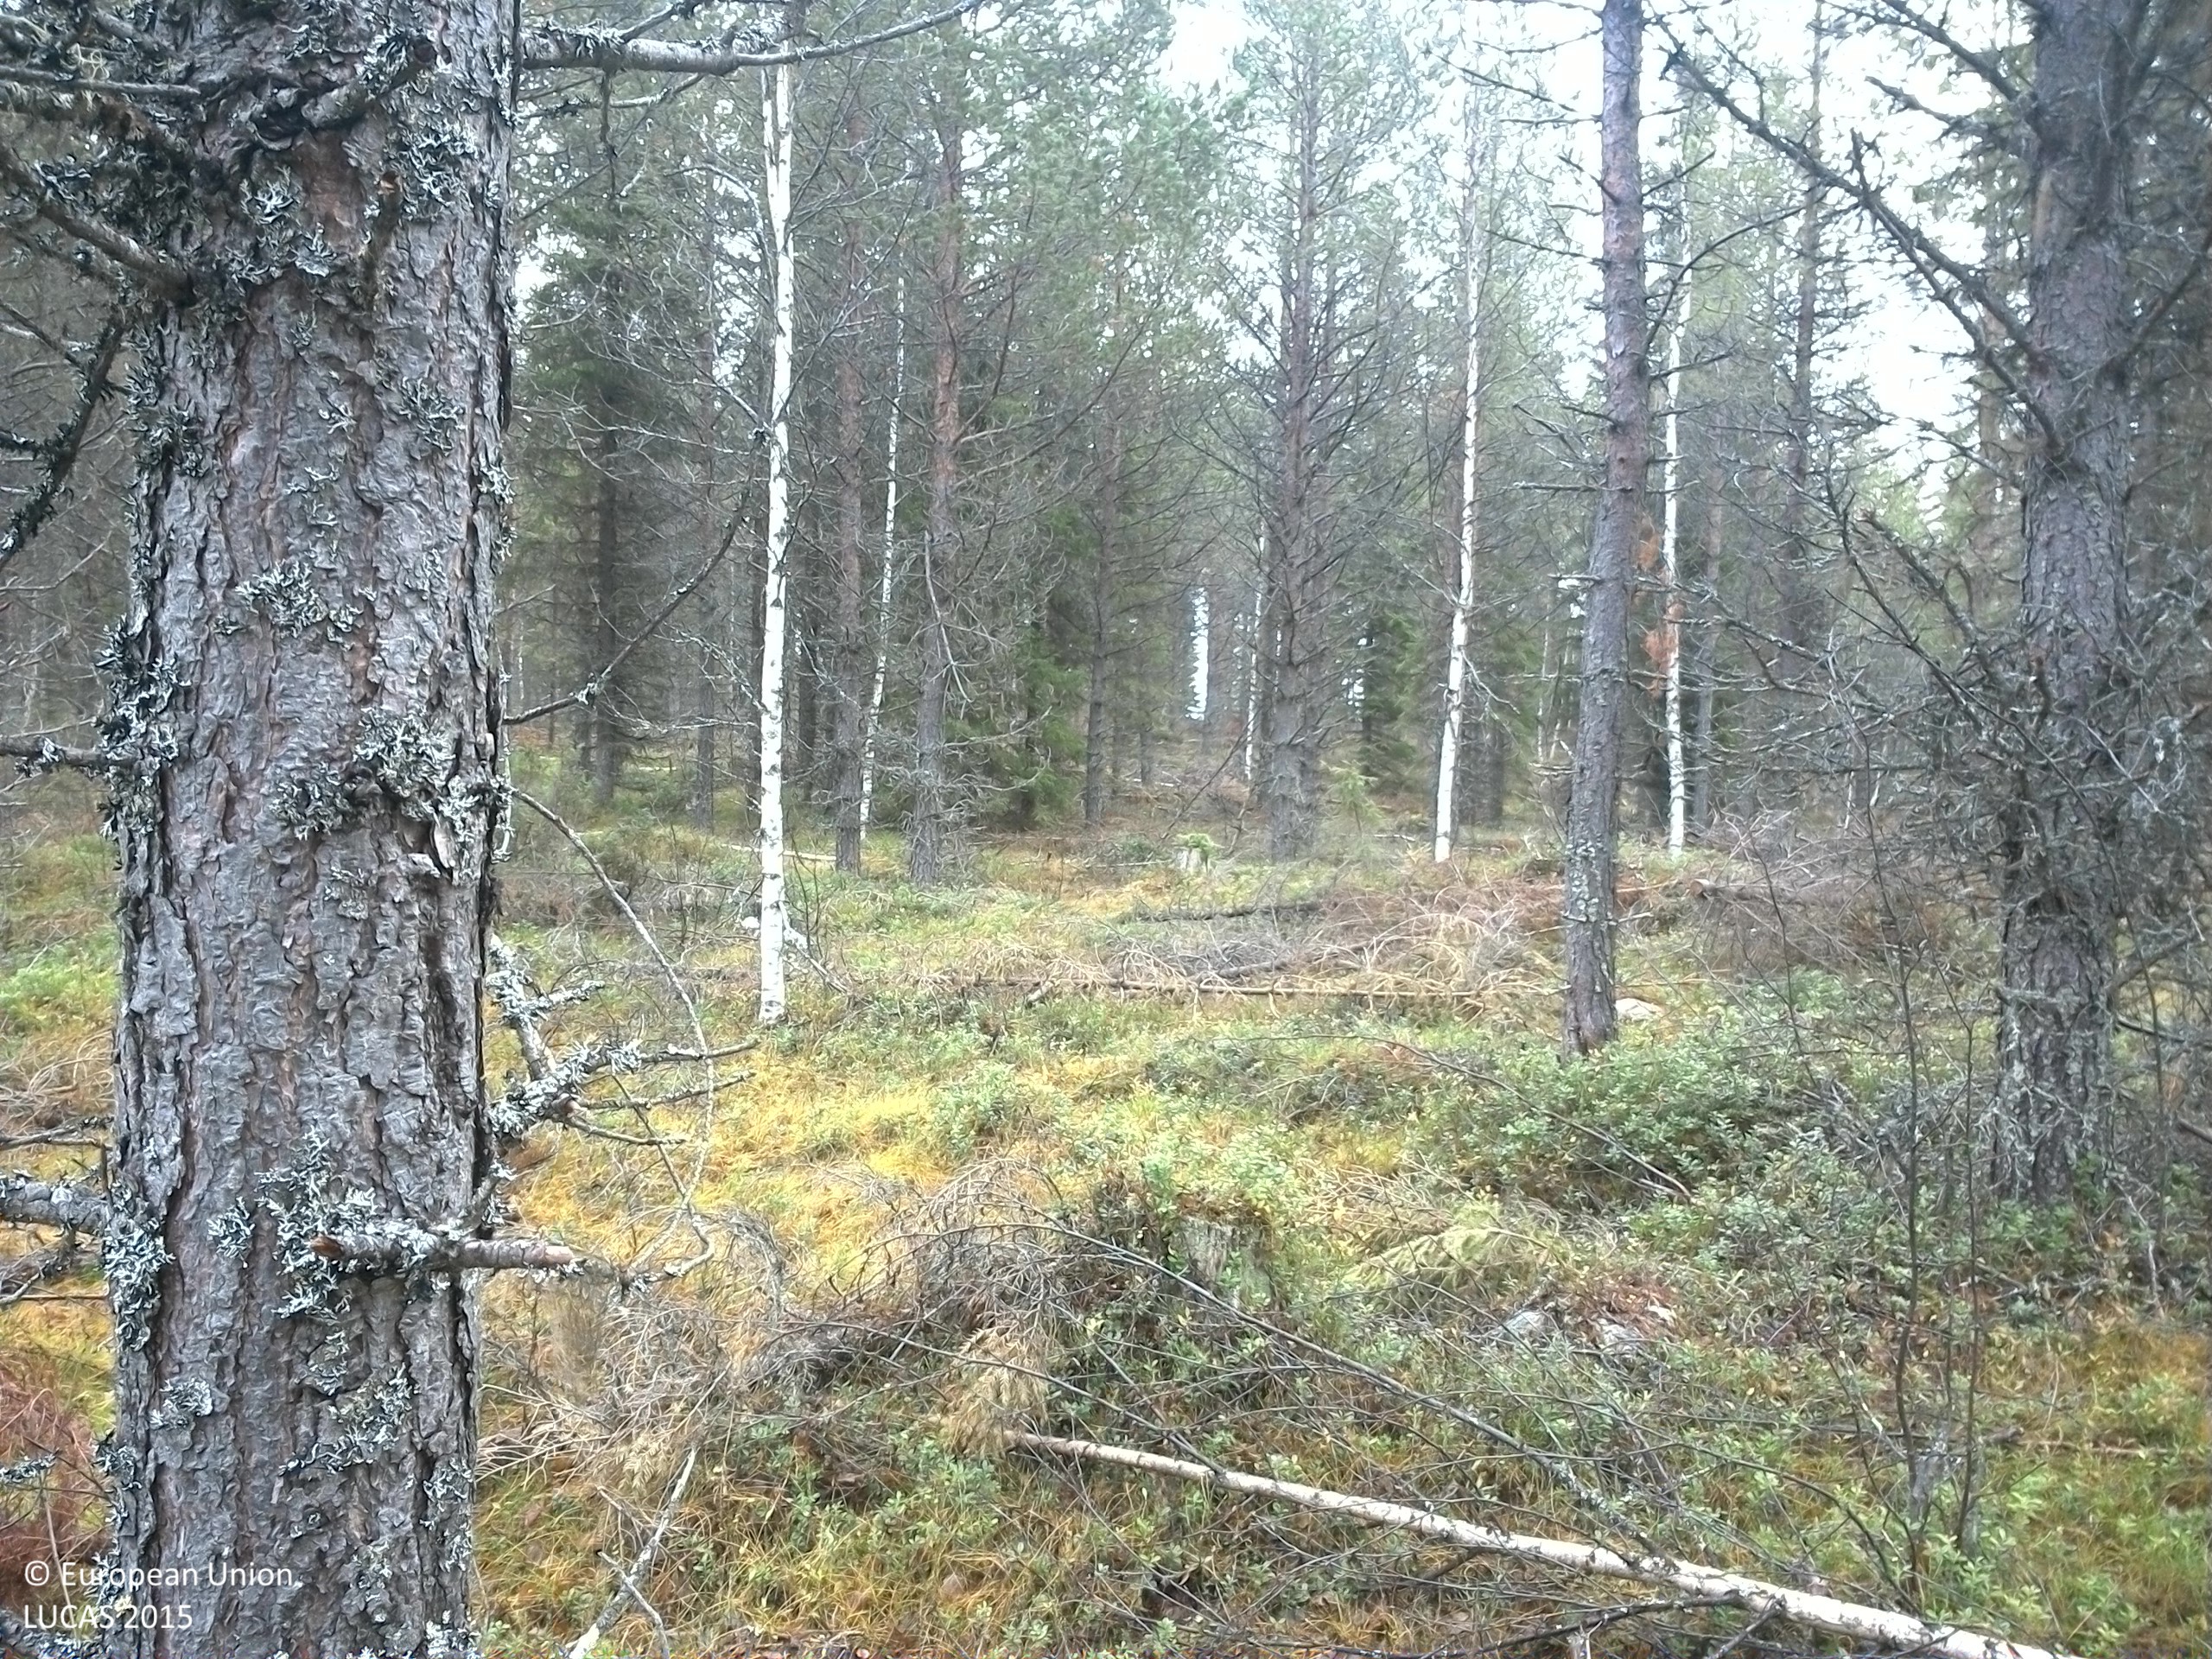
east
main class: Woodland
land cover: Pine dominated mixed woodland
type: boreal forest
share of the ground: 50 - 75 %
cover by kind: coniferous forest trees 35 %, shrubs 20 %, broadleaved forest trees 15 %, herbaceous plants 15 %, lichens and mosses 15 %
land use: Forestry
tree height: > 5 m
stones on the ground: 25 - 50 %
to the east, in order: Pine dominated mixed woodland; Spruce dominated coniferous woodland; Paved roads, cycling and walking lanes; Spruce dominated mixed woodland
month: October
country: SE
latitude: 63.9144
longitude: 15.2124
